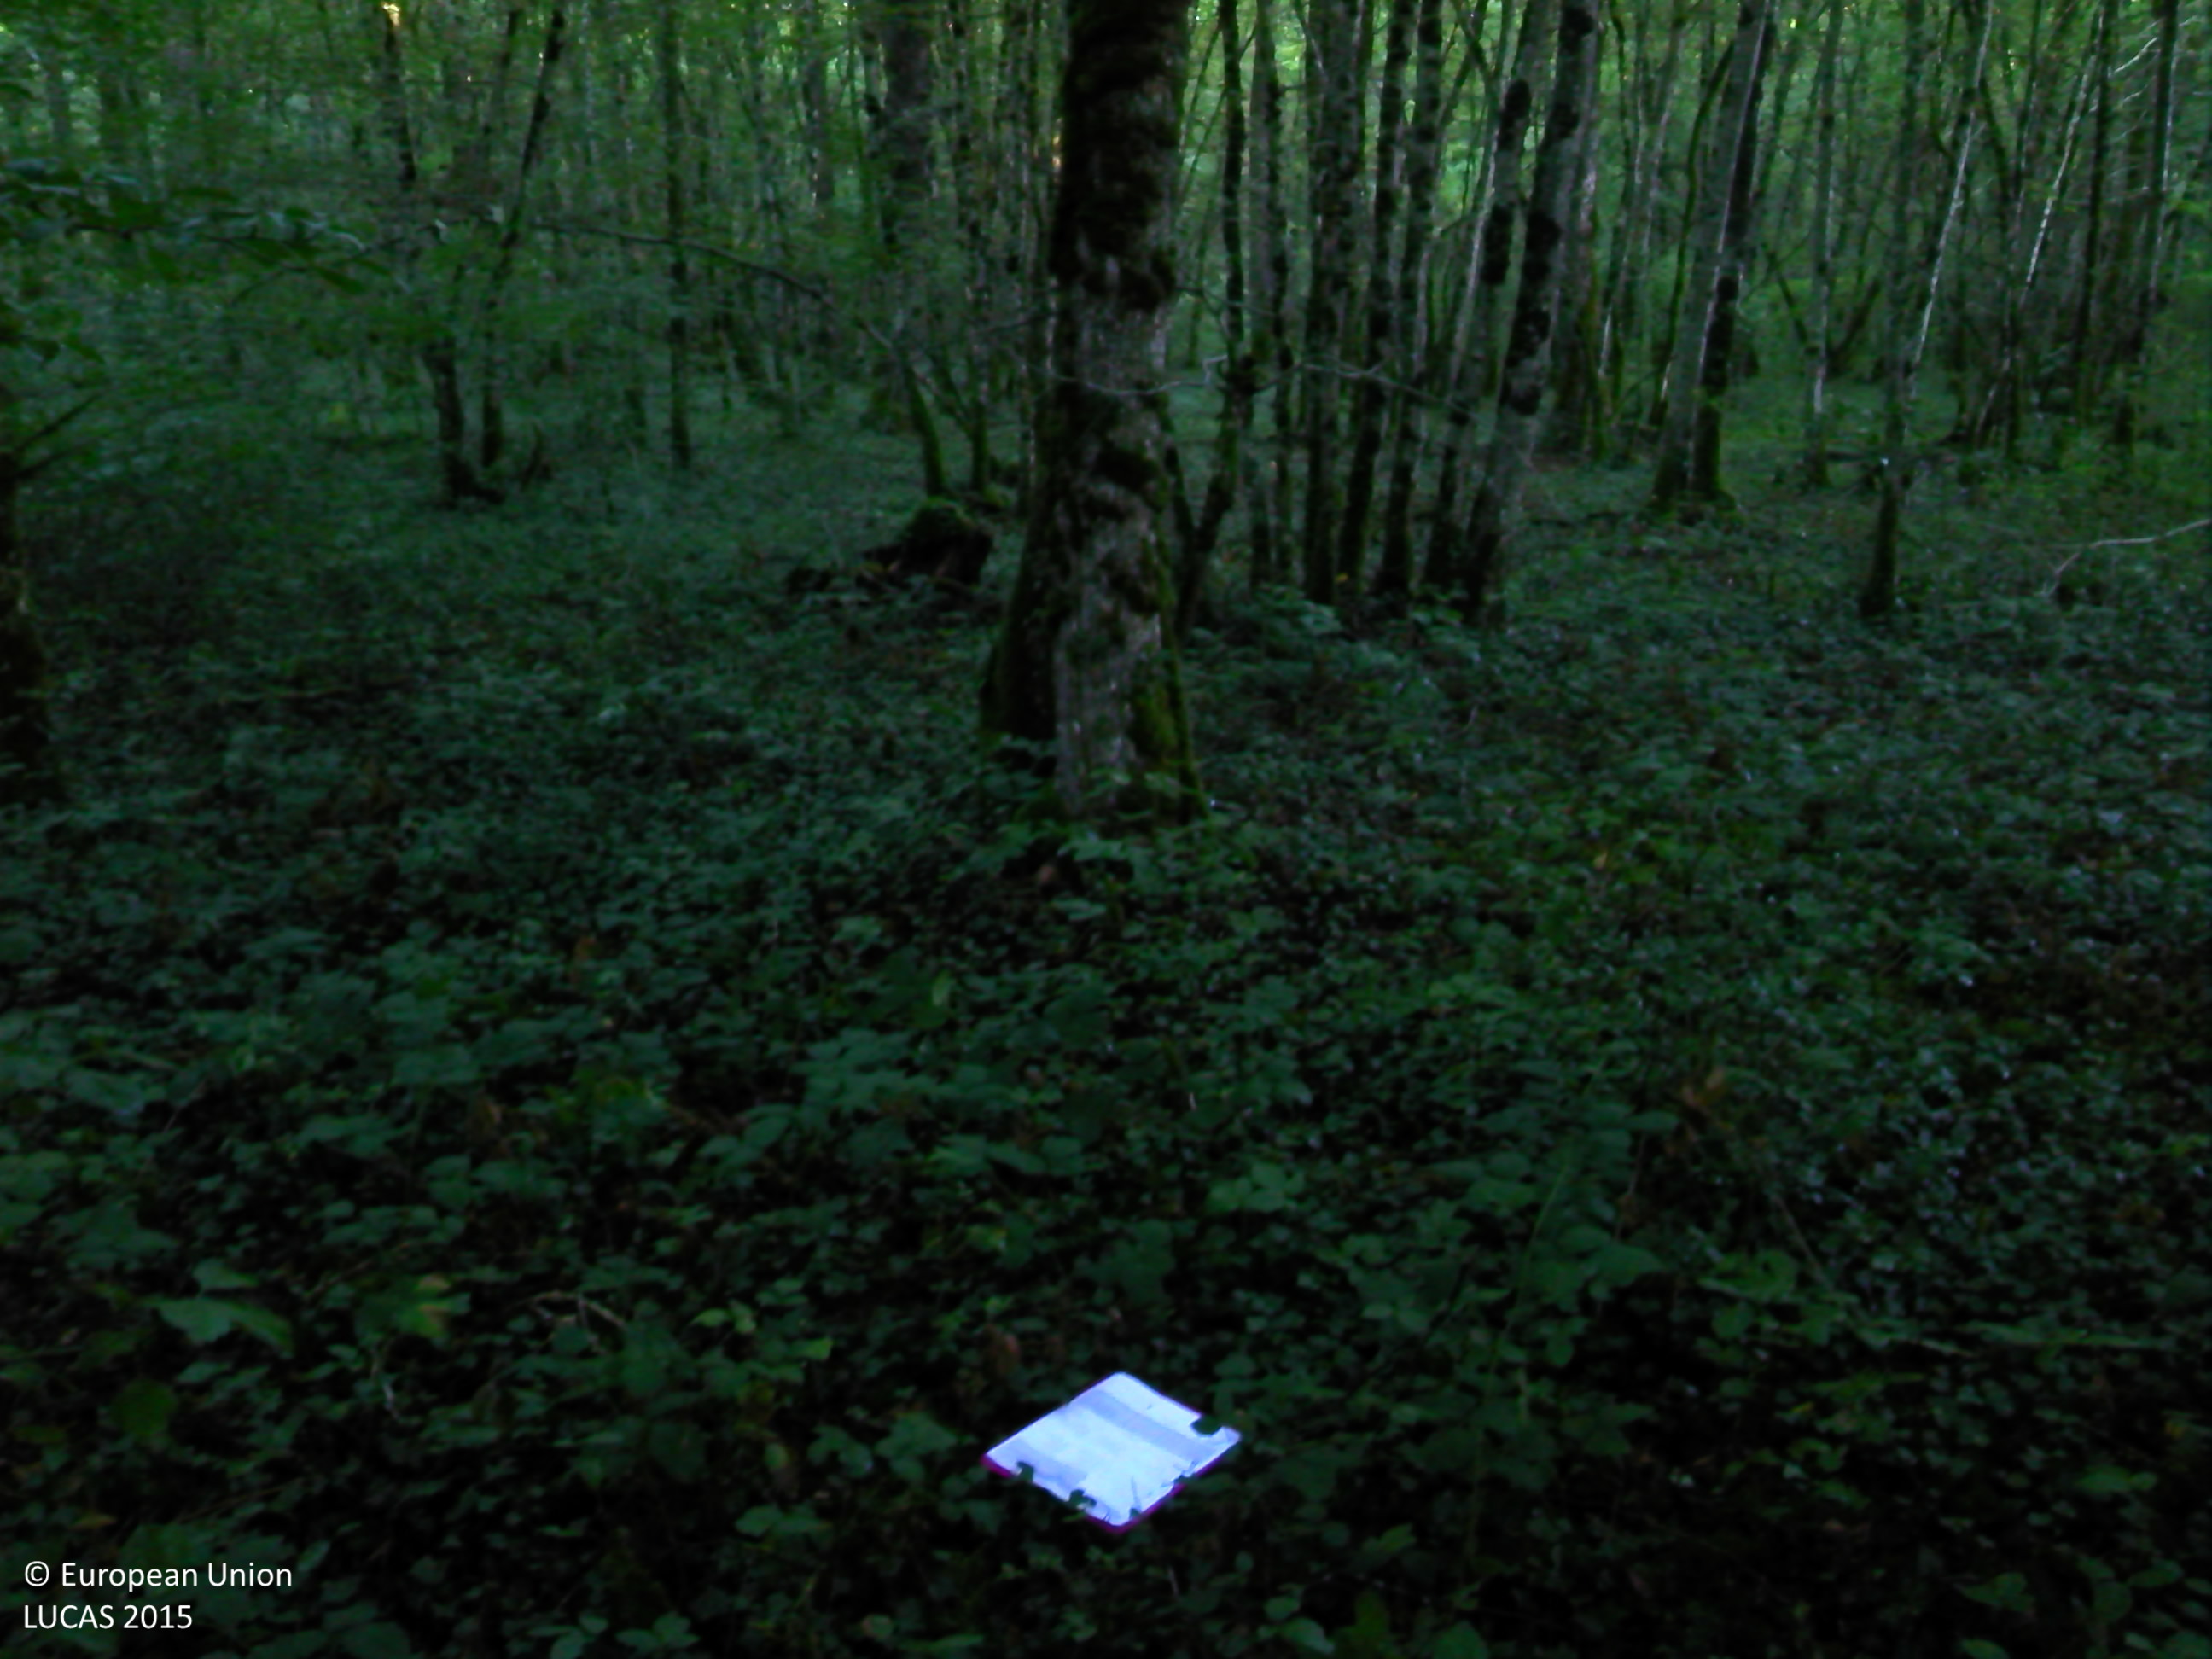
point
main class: Woodland
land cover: Broadleaved woodland
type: mesophytic deciduous forest
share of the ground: > 75 %
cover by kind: broadleaved forest trees 85 %, herbaceous plants 10 %, lichens and mosses 5 %
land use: Forestry
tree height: > 5 m
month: September
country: FR
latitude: 48.1381
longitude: 4.8248
